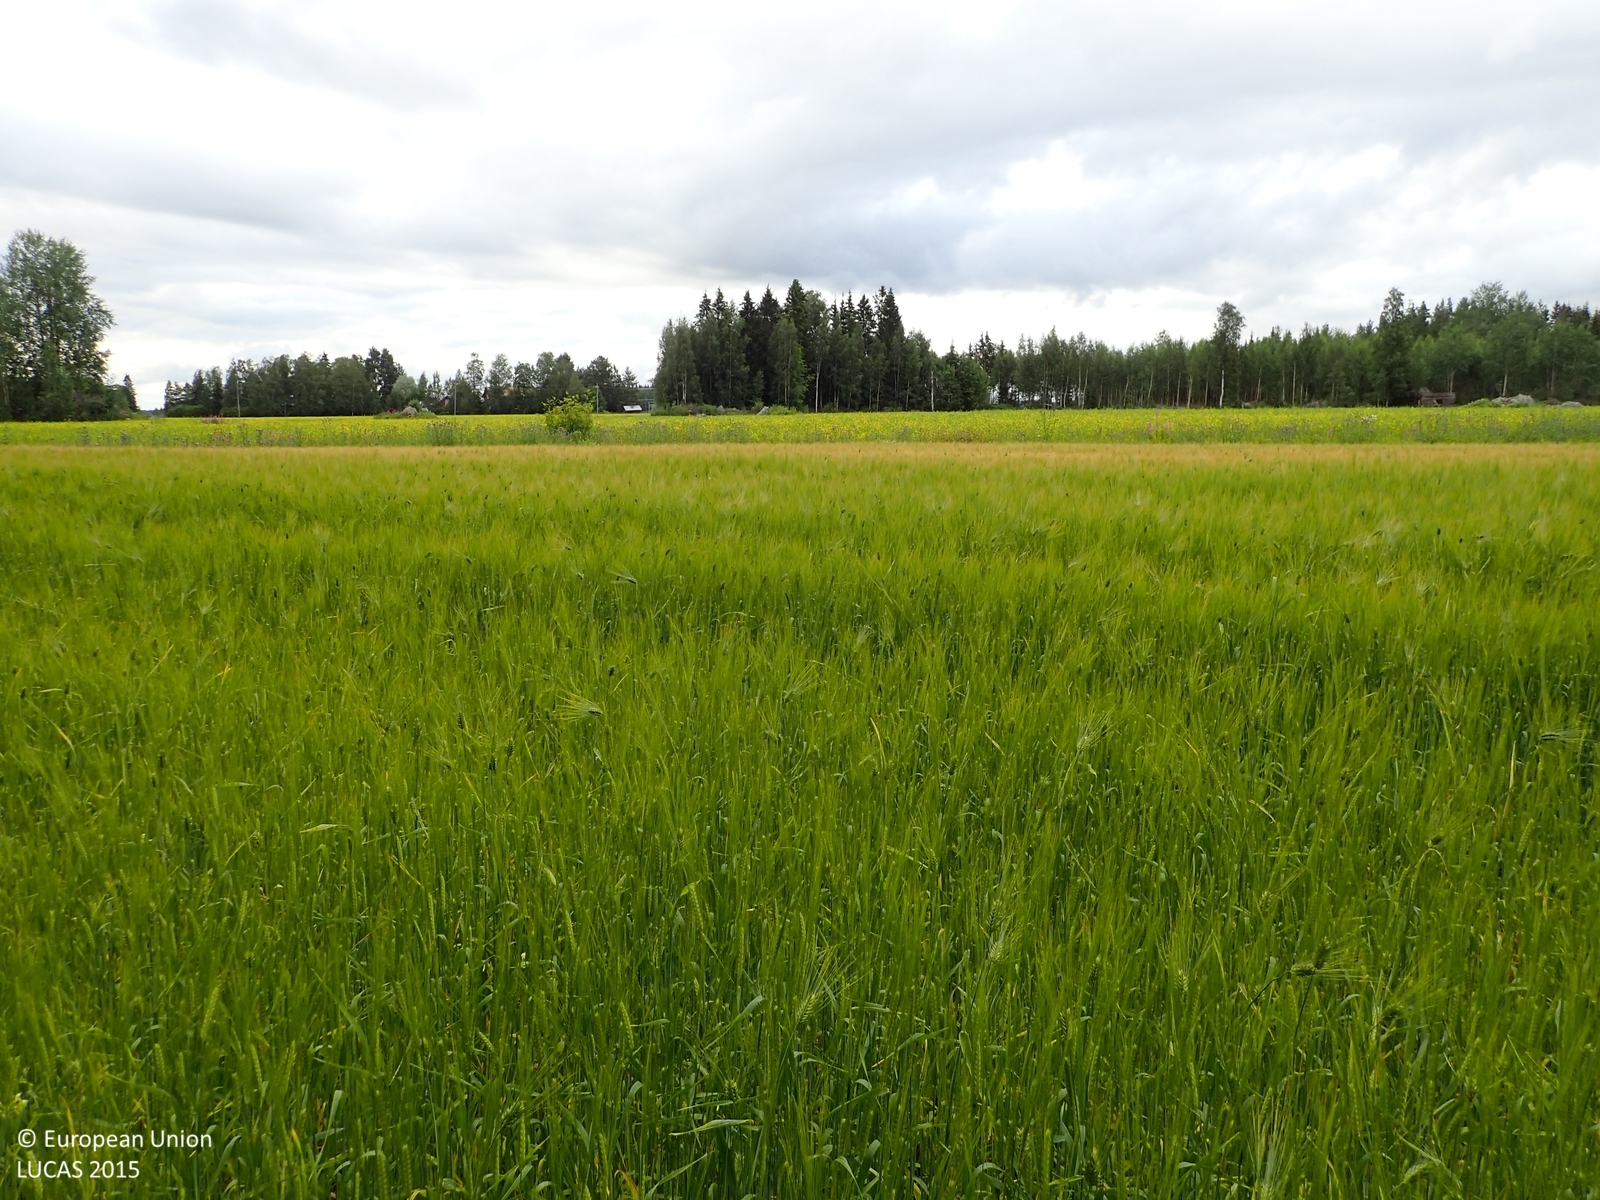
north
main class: Cropland
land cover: Barley
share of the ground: > 75 %
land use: Agriculture (excluding fallow land and kitchen gardens)
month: August
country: FI
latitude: 62.9639
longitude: 22.0952
